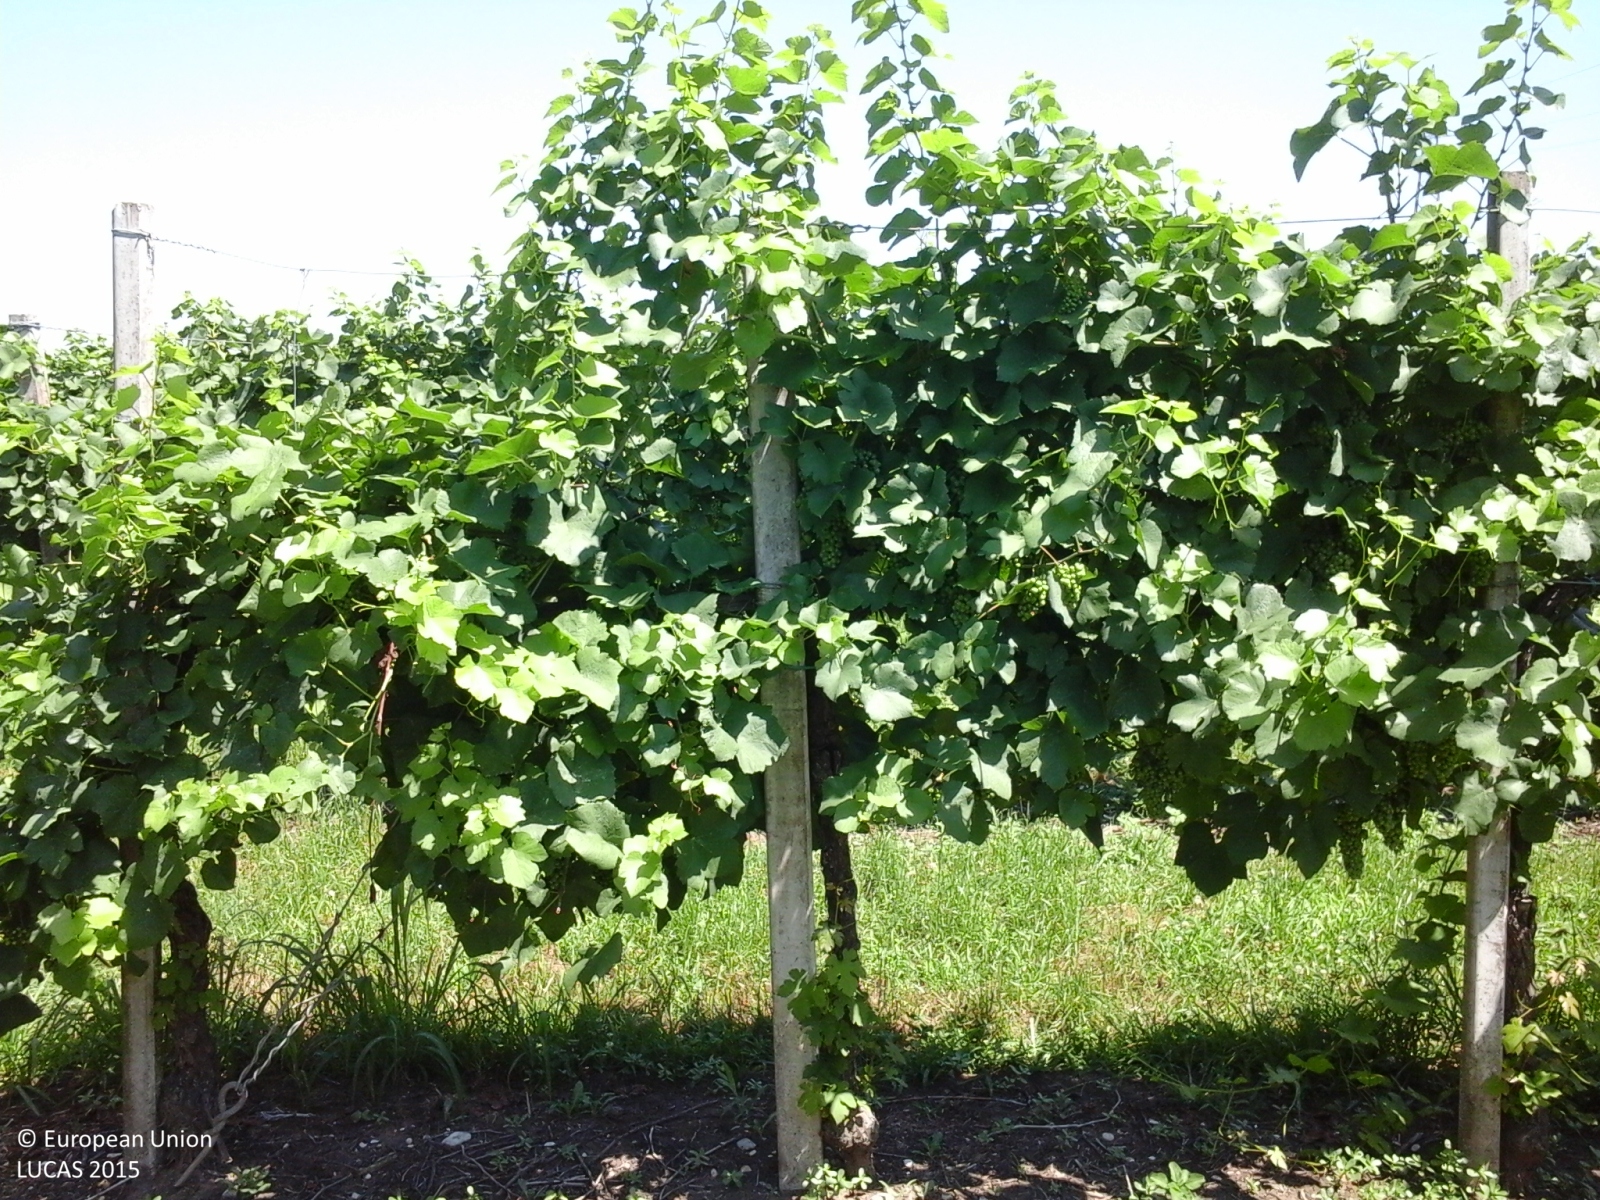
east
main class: Cropland
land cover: Vineyards
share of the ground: 25 - 50 %
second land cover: Grassland without tree/shrub cover
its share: > 75 %
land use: Agriculture (excluding fallow land and kitchen gardens)
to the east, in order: Vineyards; Grassland without tree/shrub cover; Electric lines; Vineyards
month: July
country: IT
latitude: 45.8027
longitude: 12.3513
